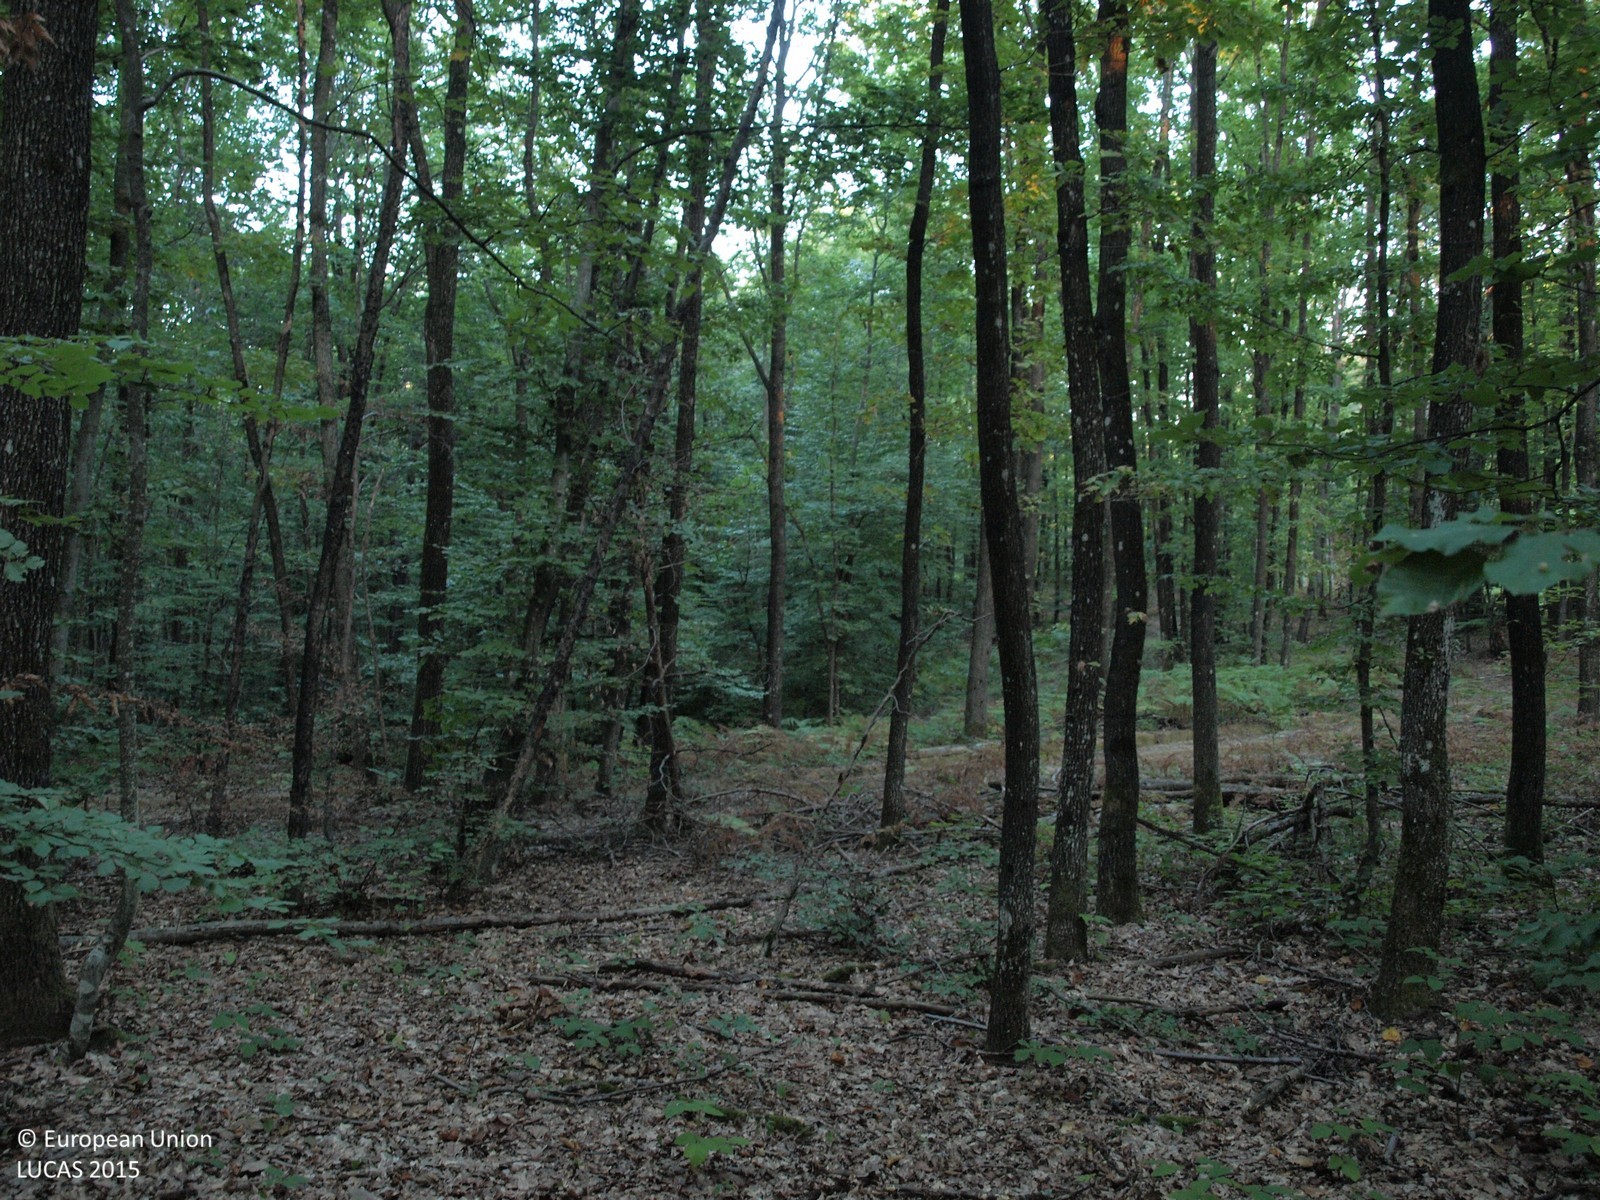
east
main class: Woodland
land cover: Broadleaved woodland
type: mesophytic deciduous forest
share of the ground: > 75 %
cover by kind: broadleaved forest trees 100 %
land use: Forestry
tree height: > 5 m
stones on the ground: < 10 %
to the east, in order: Broadleaved woodland; Paved roads, cycling and walking lanes; Shrubland with sparse tree cover
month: September
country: HR
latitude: 45.5294
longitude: 16.0537
